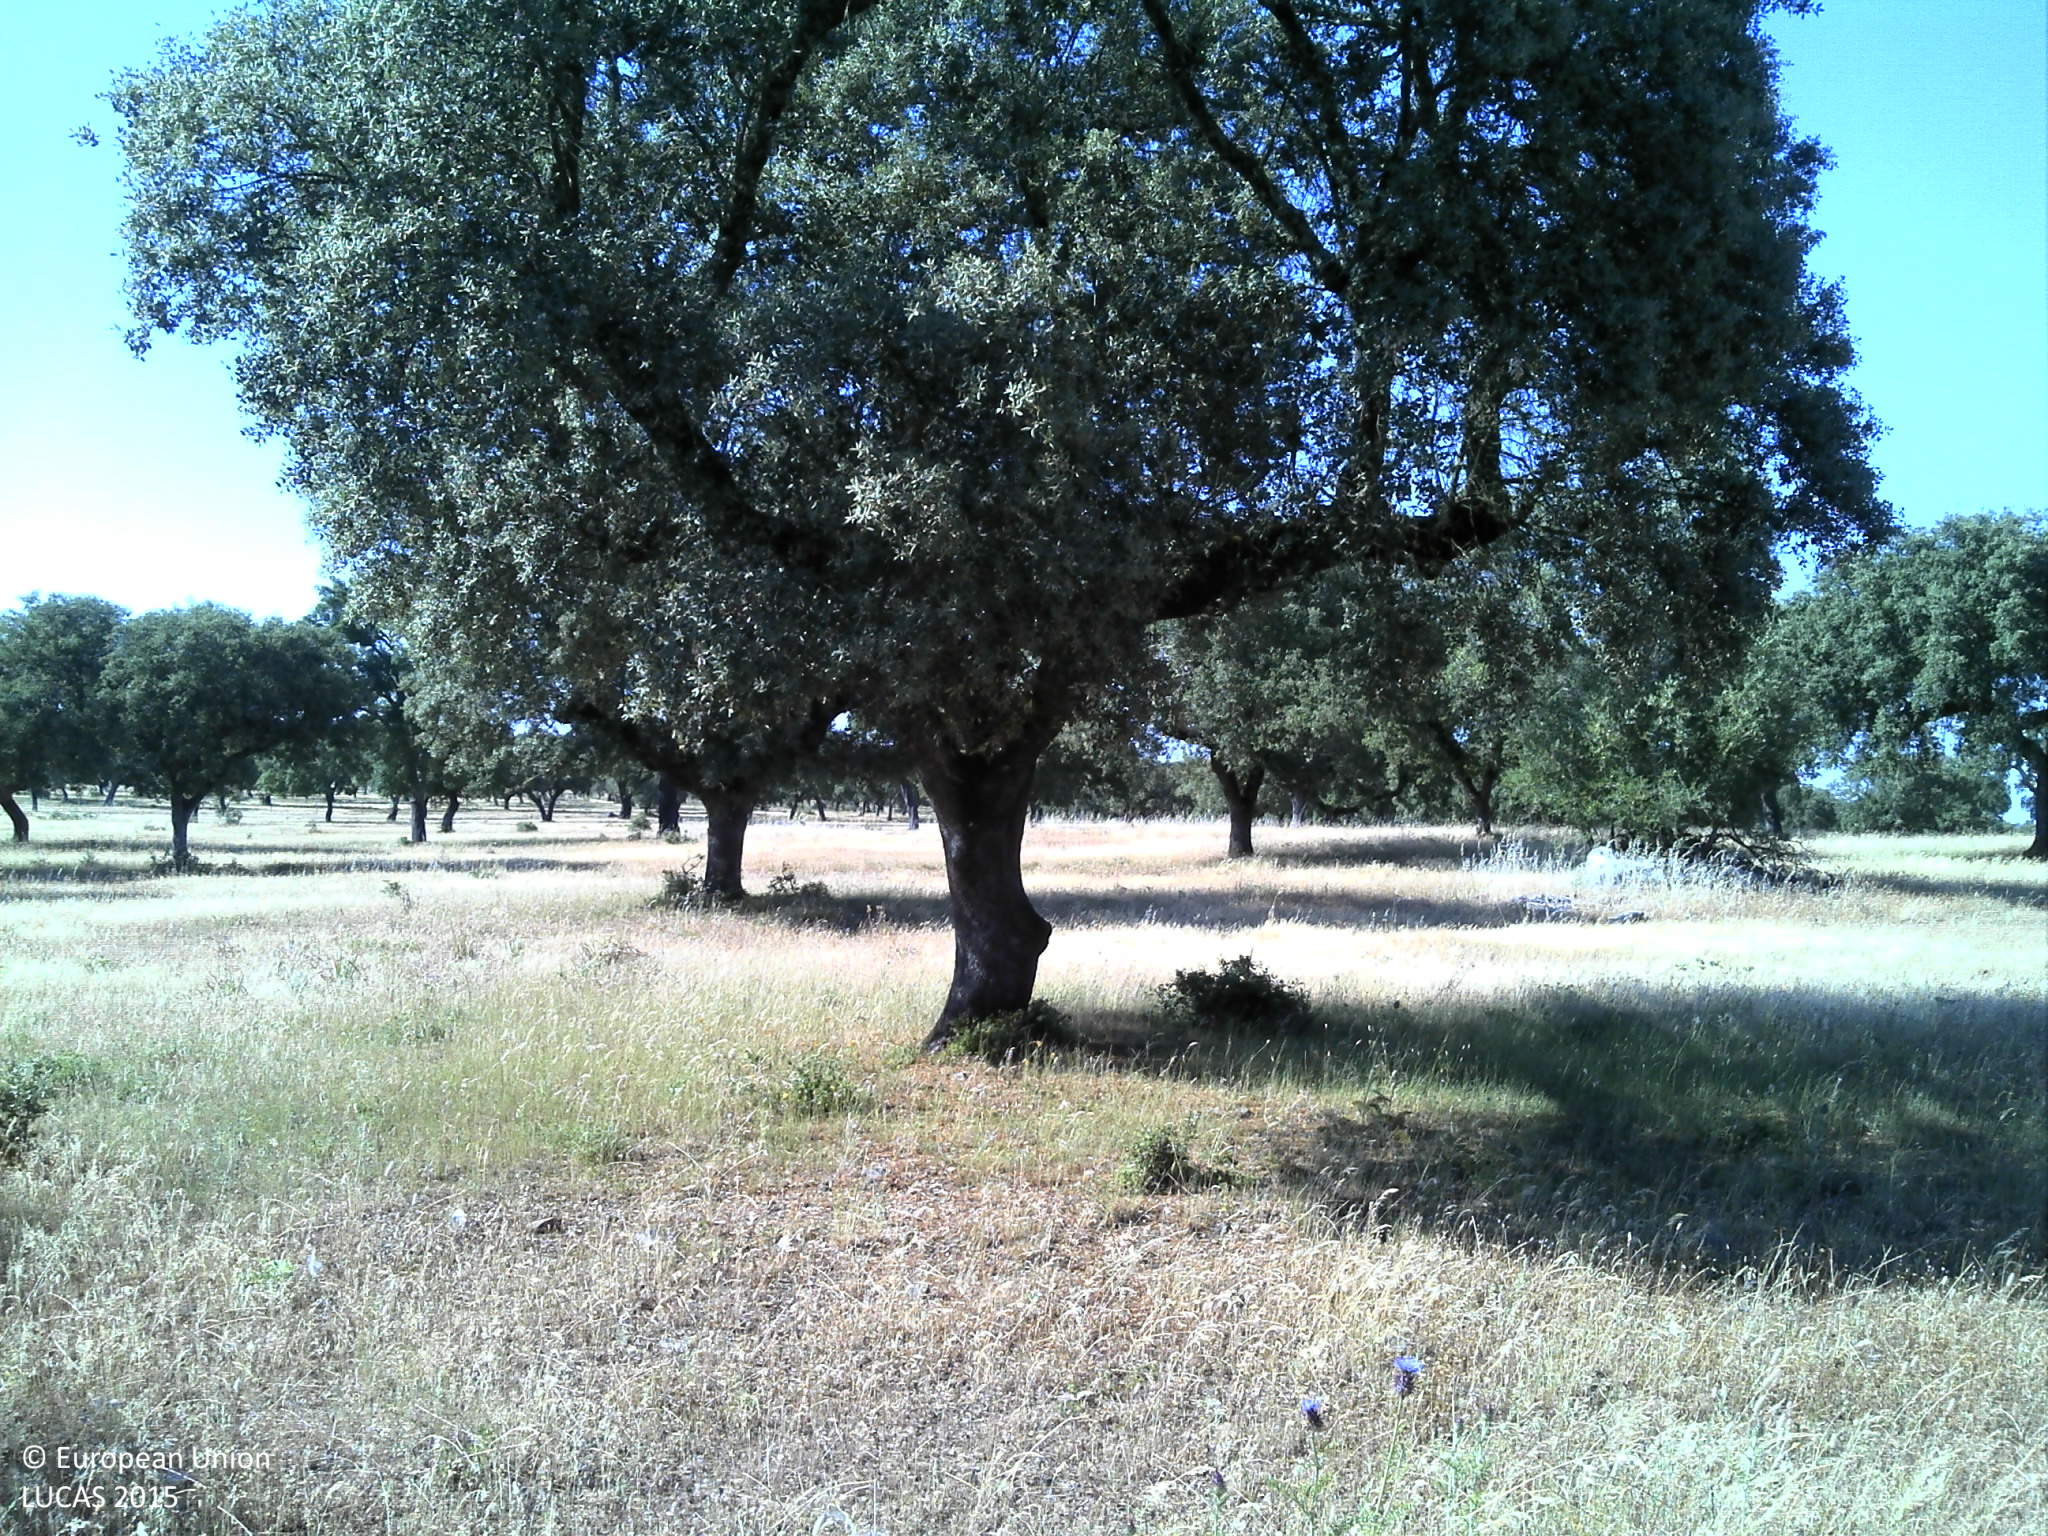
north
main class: Woodland
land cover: Broadleaved woodland
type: broadleaved evergreen forest
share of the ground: 25 - 50 %
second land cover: Grassland without tree/shrub cover
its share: 50 - 75 %
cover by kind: herbaceous plants 60 %, broadleaved forest trees 30 %, unconsolidated bare surface 10 %
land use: Forestry
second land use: Agriculture (excluding fallow land and kitchen gardens)
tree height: > 5 m
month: June
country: PT
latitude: 38.7306
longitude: -8.1193
